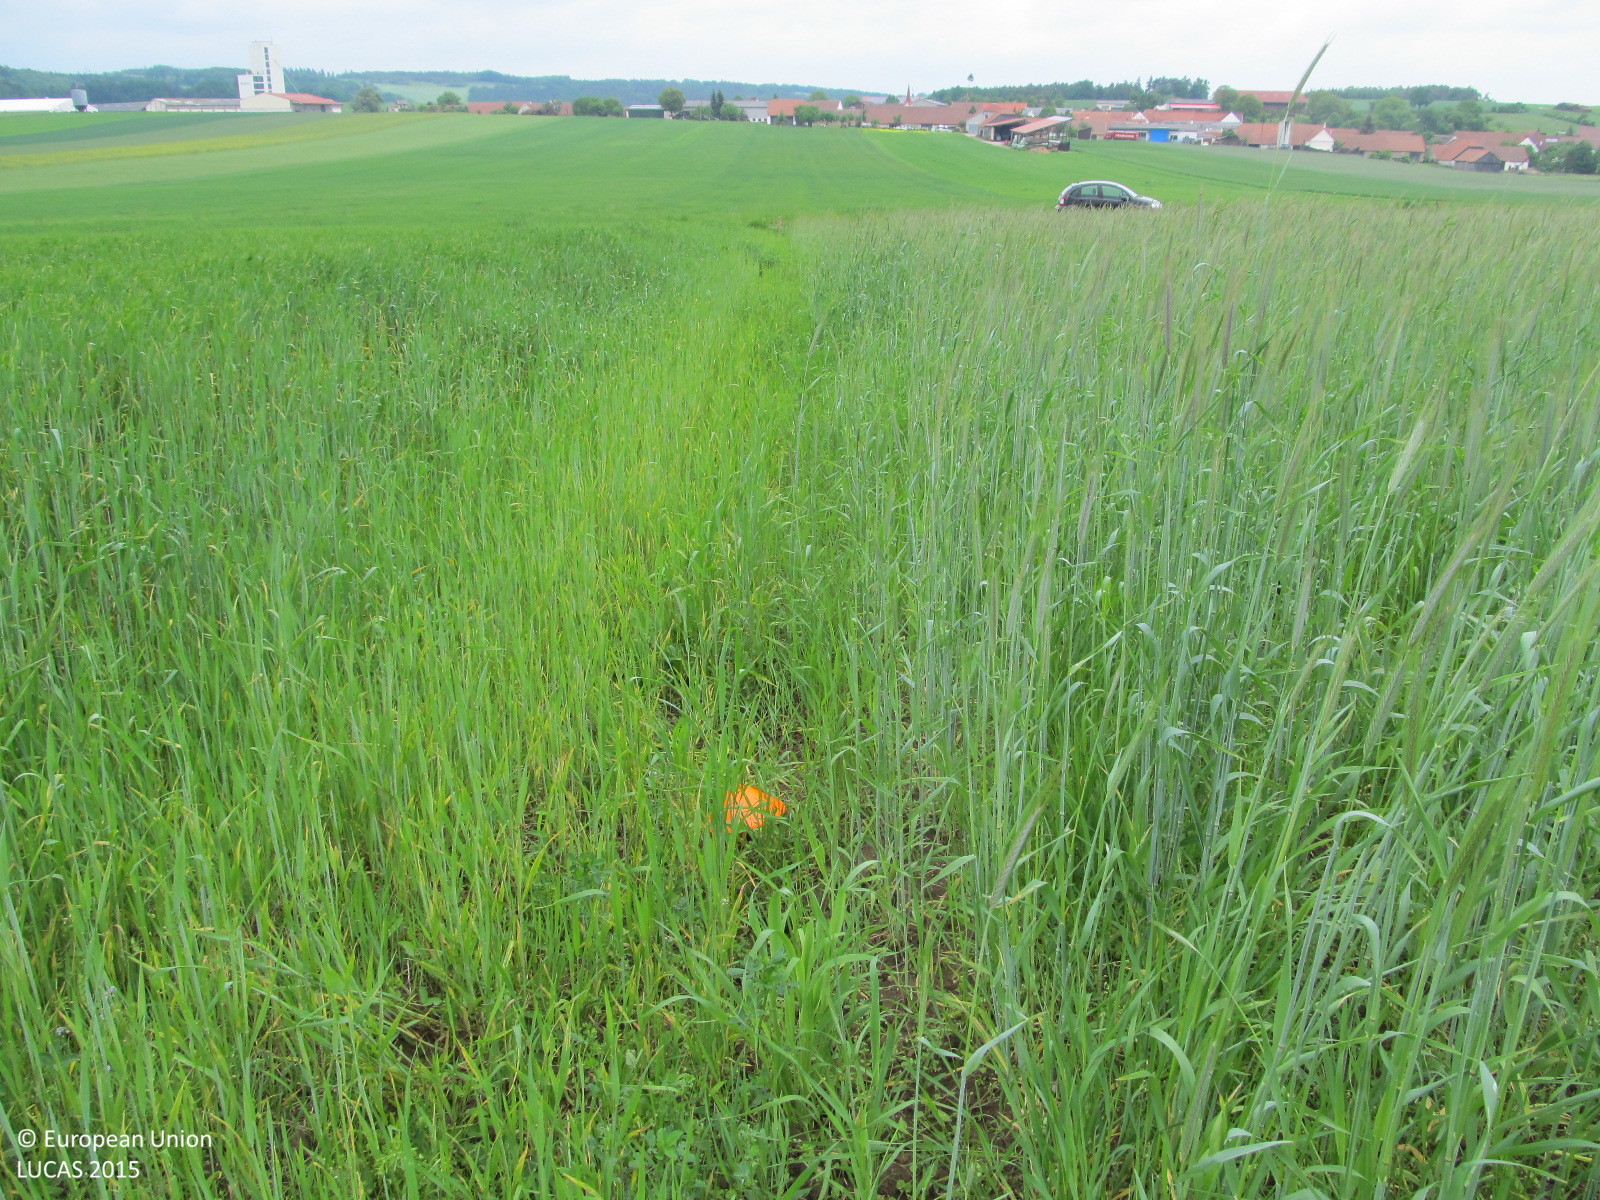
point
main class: Cropland
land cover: Common wheat
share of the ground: > 75 %
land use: Agriculture (excluding fallow land and kitchen gardens)
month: May
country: AT
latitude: 48.6646
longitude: 15.4748
